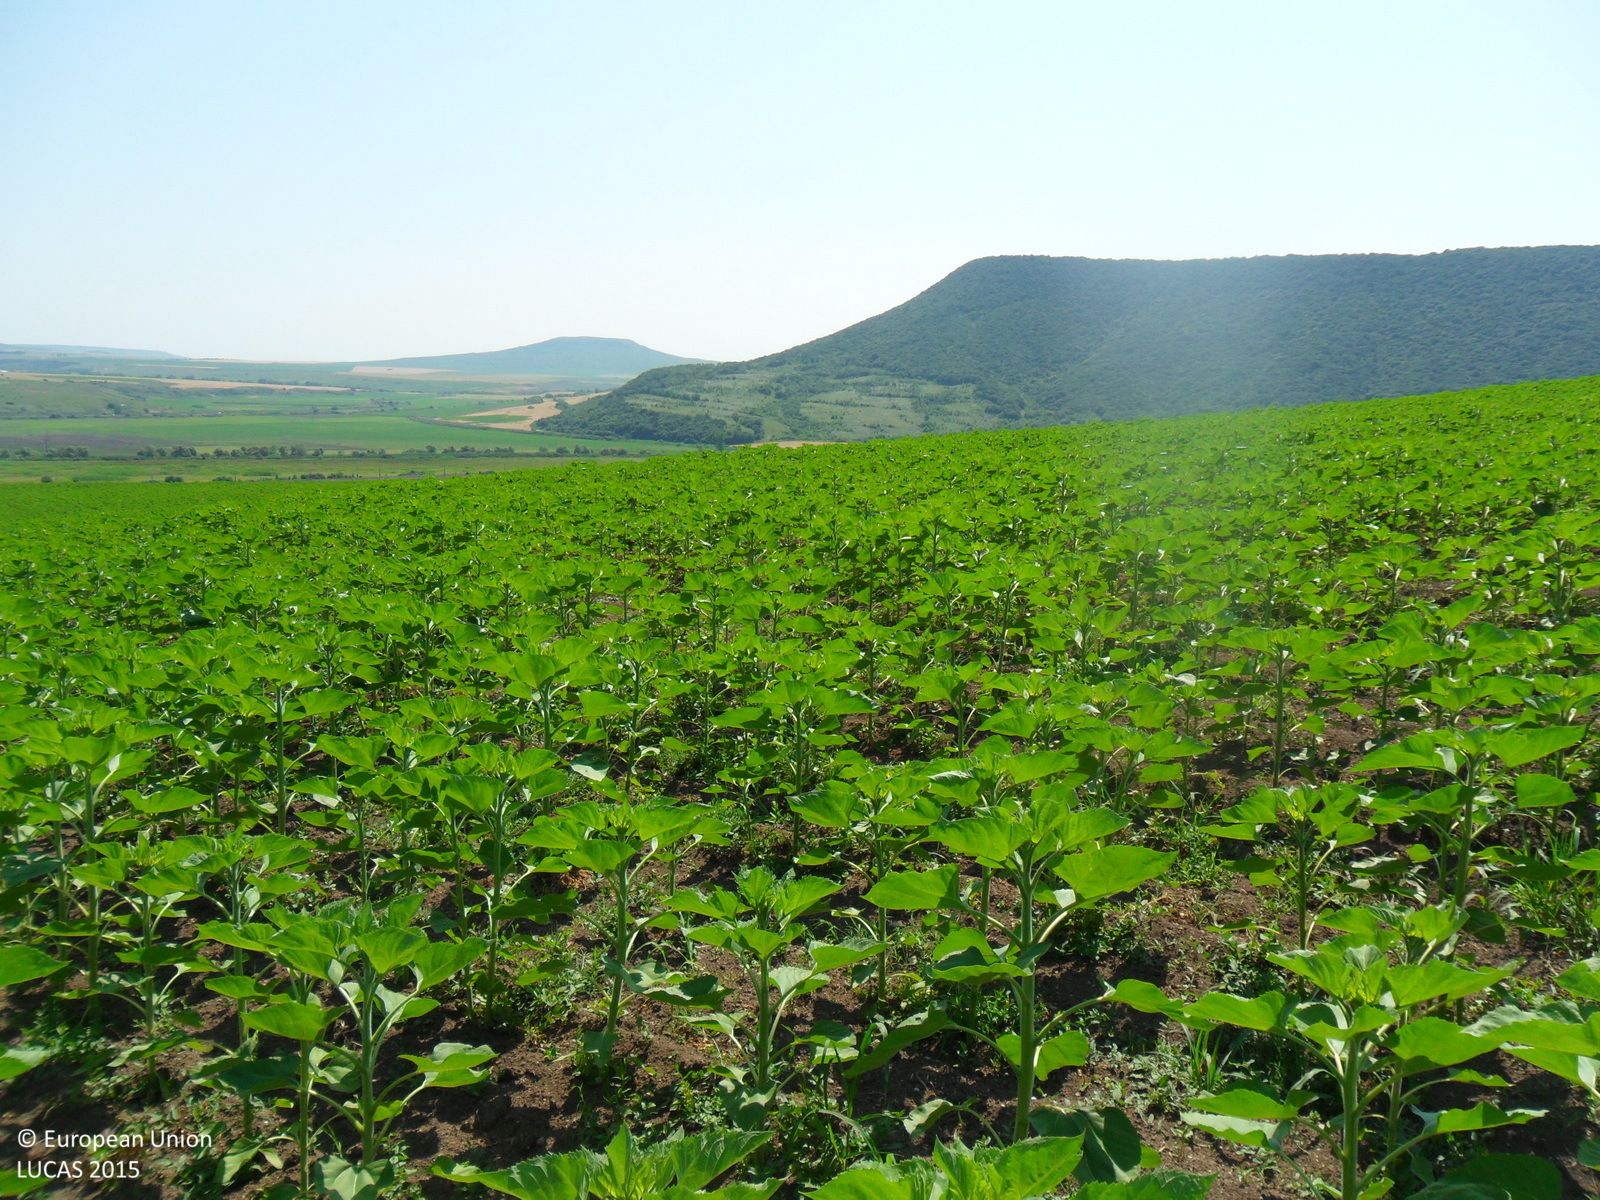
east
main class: Cropland
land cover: Sunflower
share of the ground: > 75 %
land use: Agriculture (excluding fallow land and kitchen gardens)
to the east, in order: Sunflower; Grassland with sparse tree/shrub cover
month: June
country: BG
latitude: 43.2854
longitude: 27.2137
